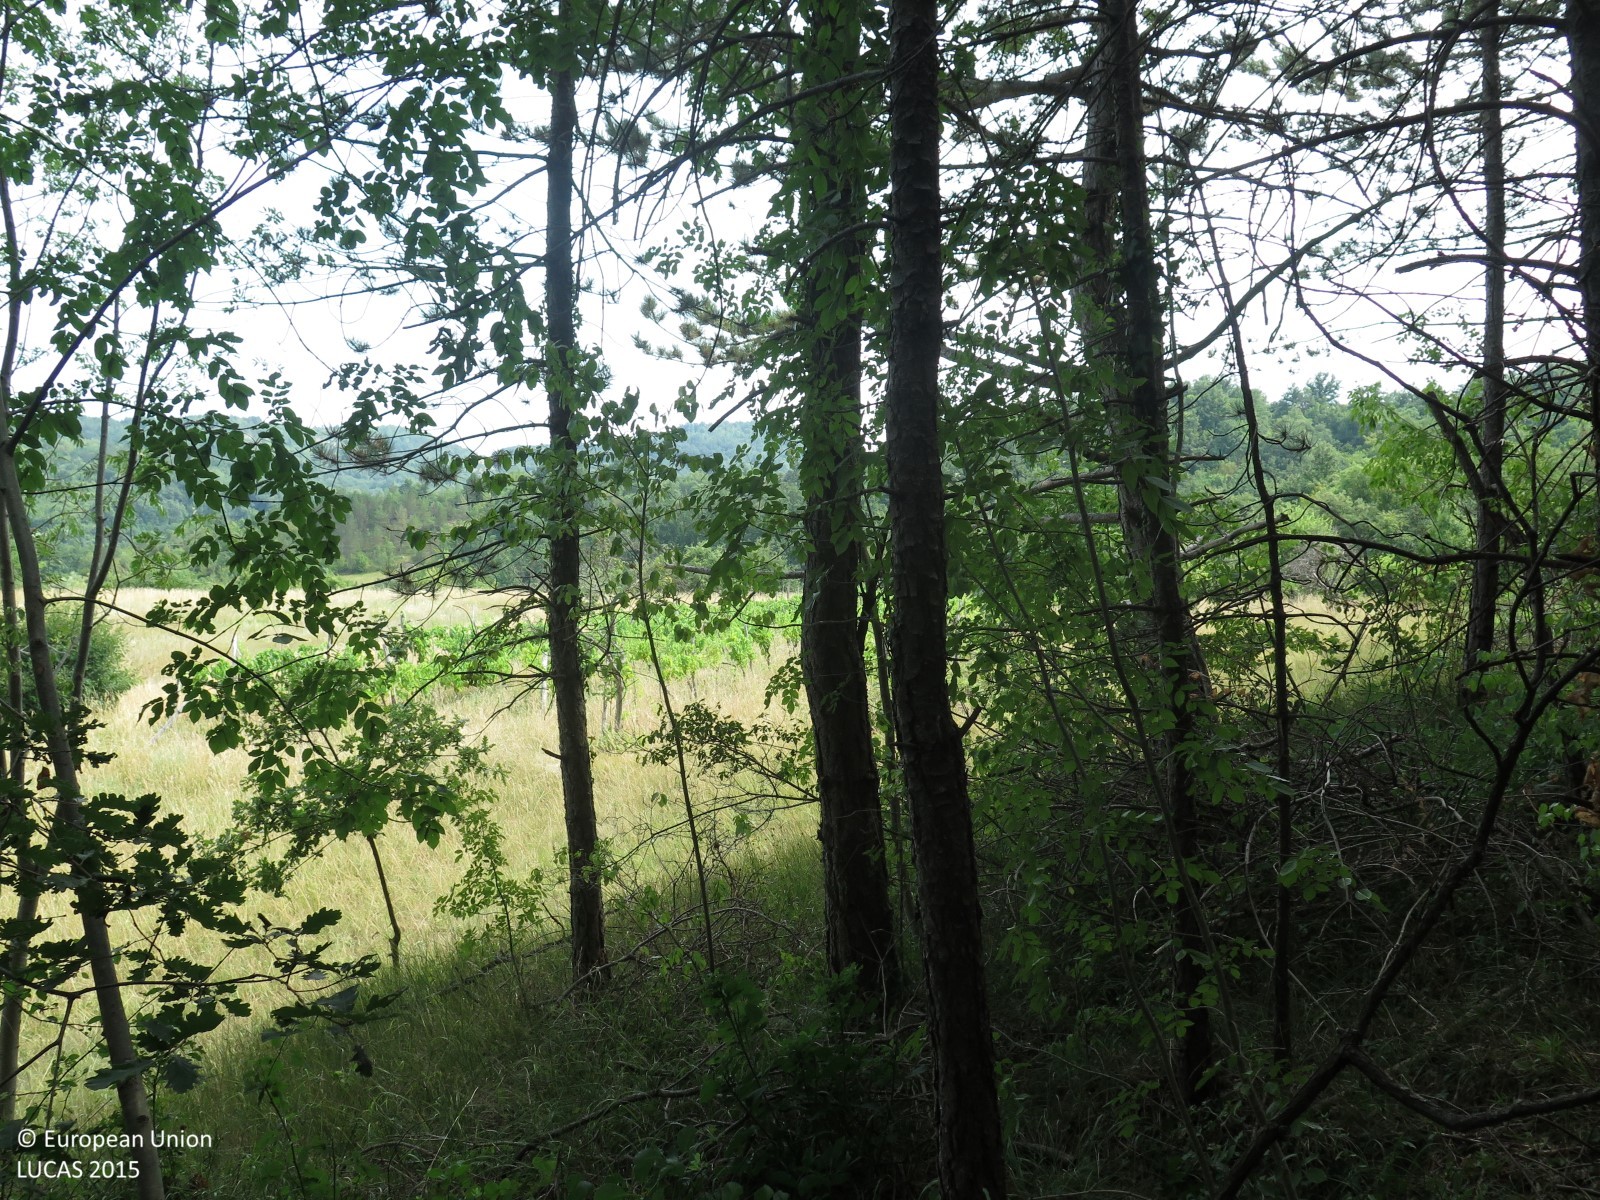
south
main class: Woodland
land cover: Pine dominated mixed woodland
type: coniferous forest of the mediterranean region
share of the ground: > 75 %
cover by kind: coniferous forest trees 75 %, broadleaved forest trees 25 %
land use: Semi-natural and natural areas not in use
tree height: > 5 m
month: July
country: HR
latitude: 45.2819
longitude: 14.0616
